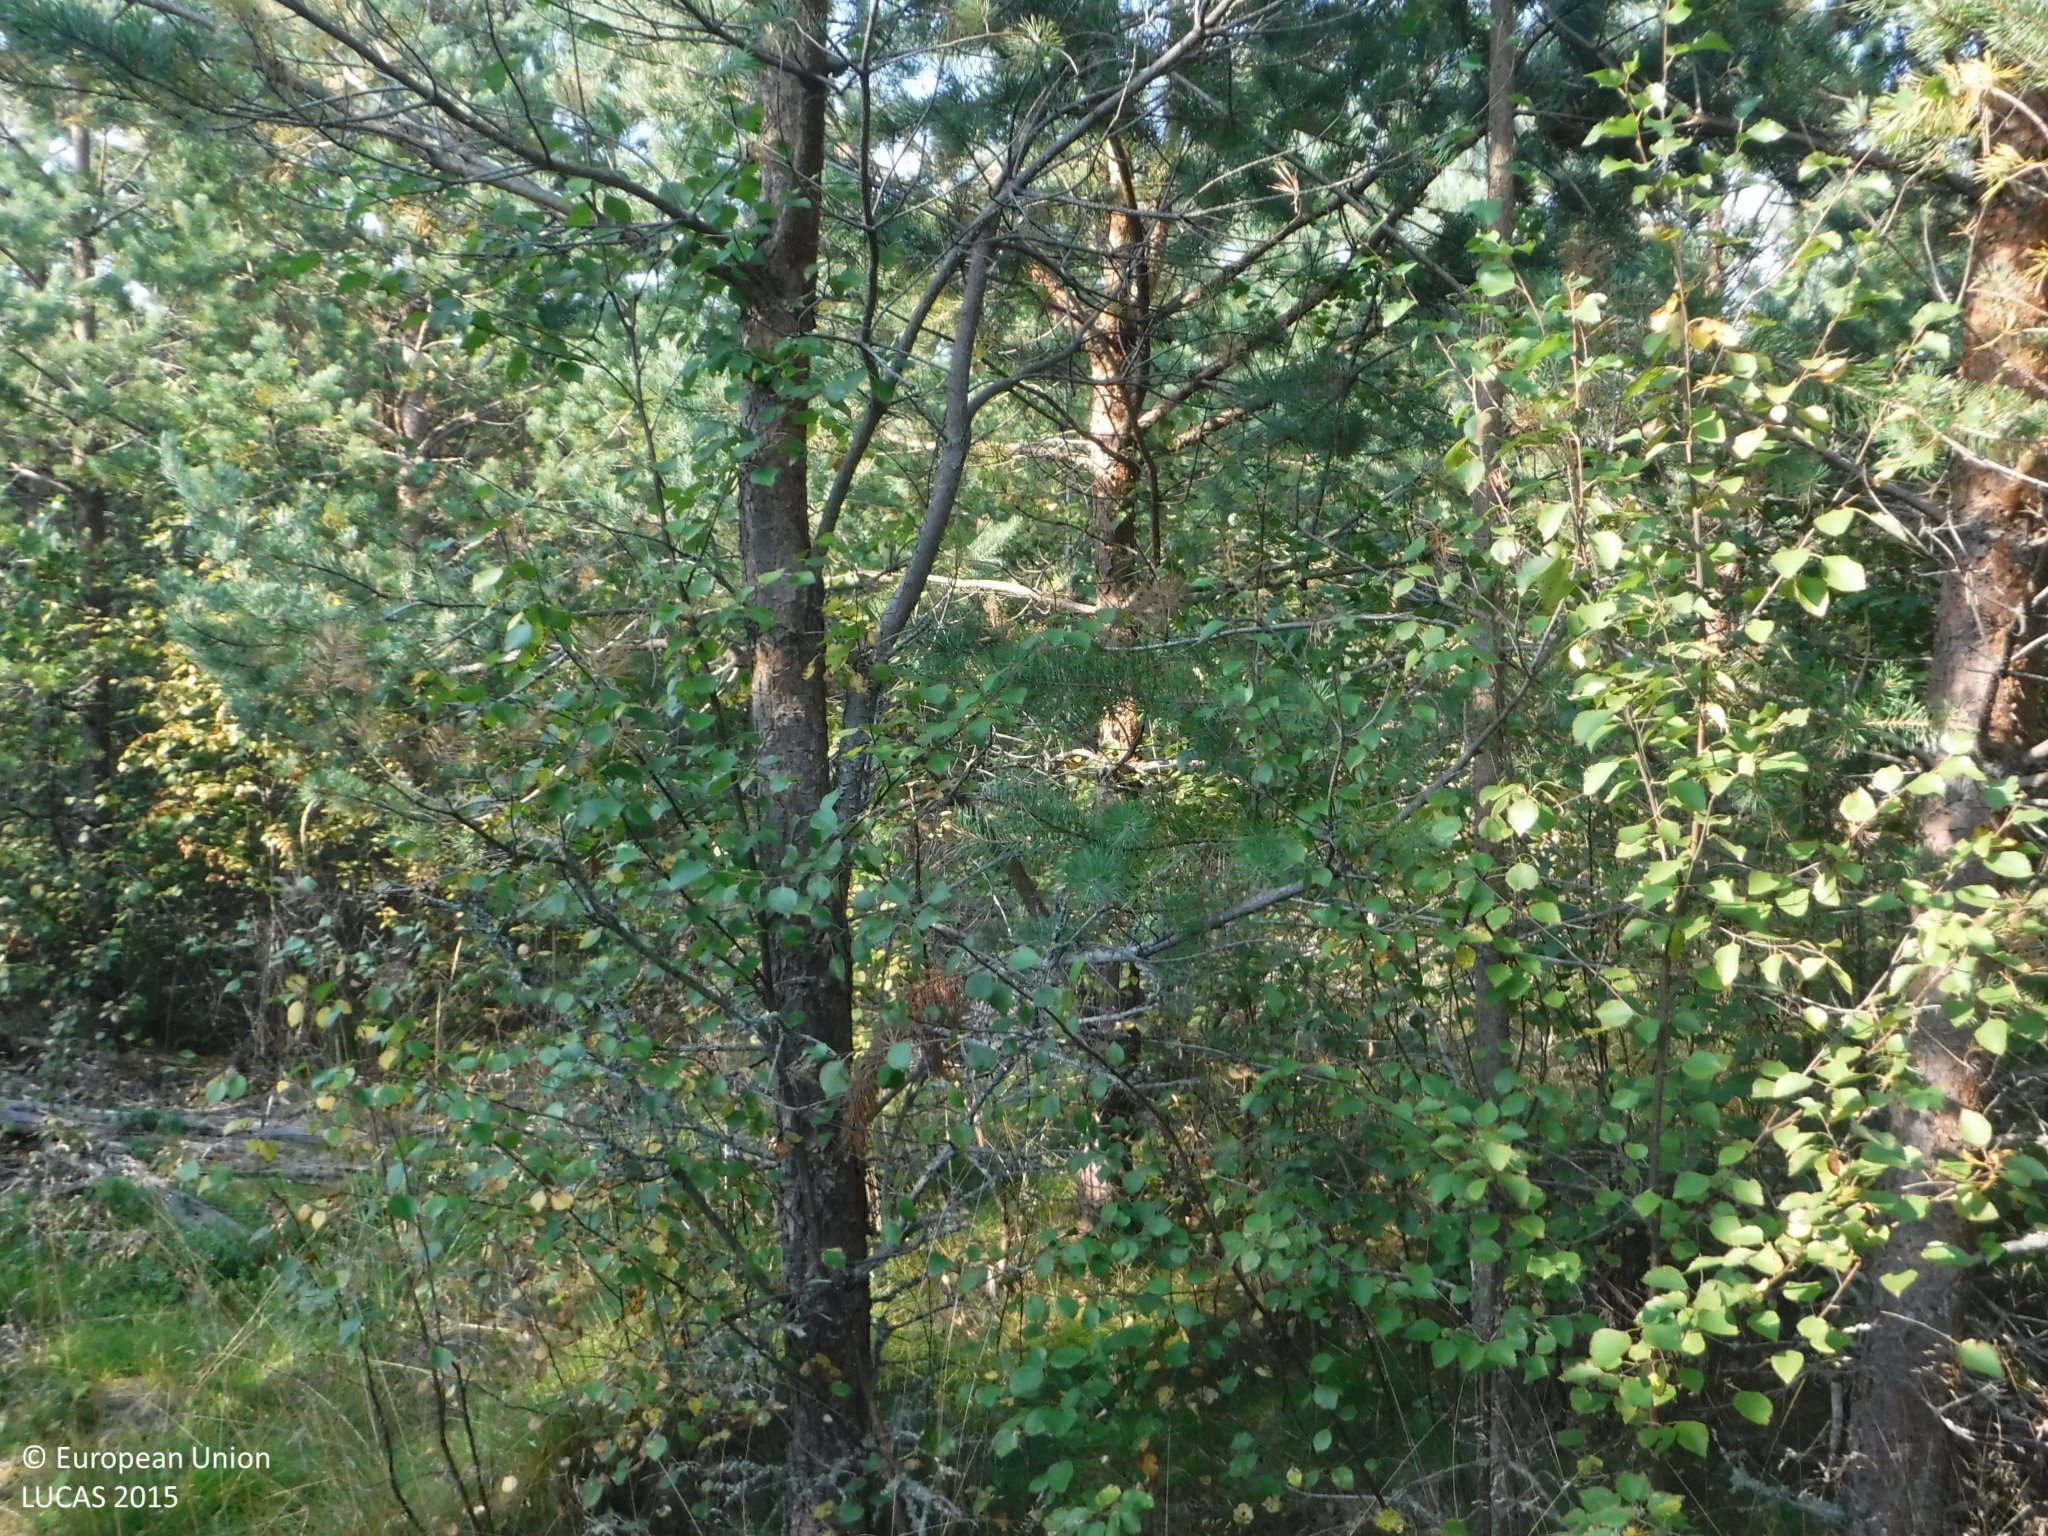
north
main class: Woodland
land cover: Pine dominated coniferous woodland
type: boreal forest
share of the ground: 25 - 50 %
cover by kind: herbaceous plants 50 %, coniferous forest trees 30 %, shrubs 10 %, broadleaved forest trees 5 %, lichens and mosses 5 %
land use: Forestry
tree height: > 5 m
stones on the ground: < 10 %
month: August
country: FI
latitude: 61.2559
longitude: 23.0287
